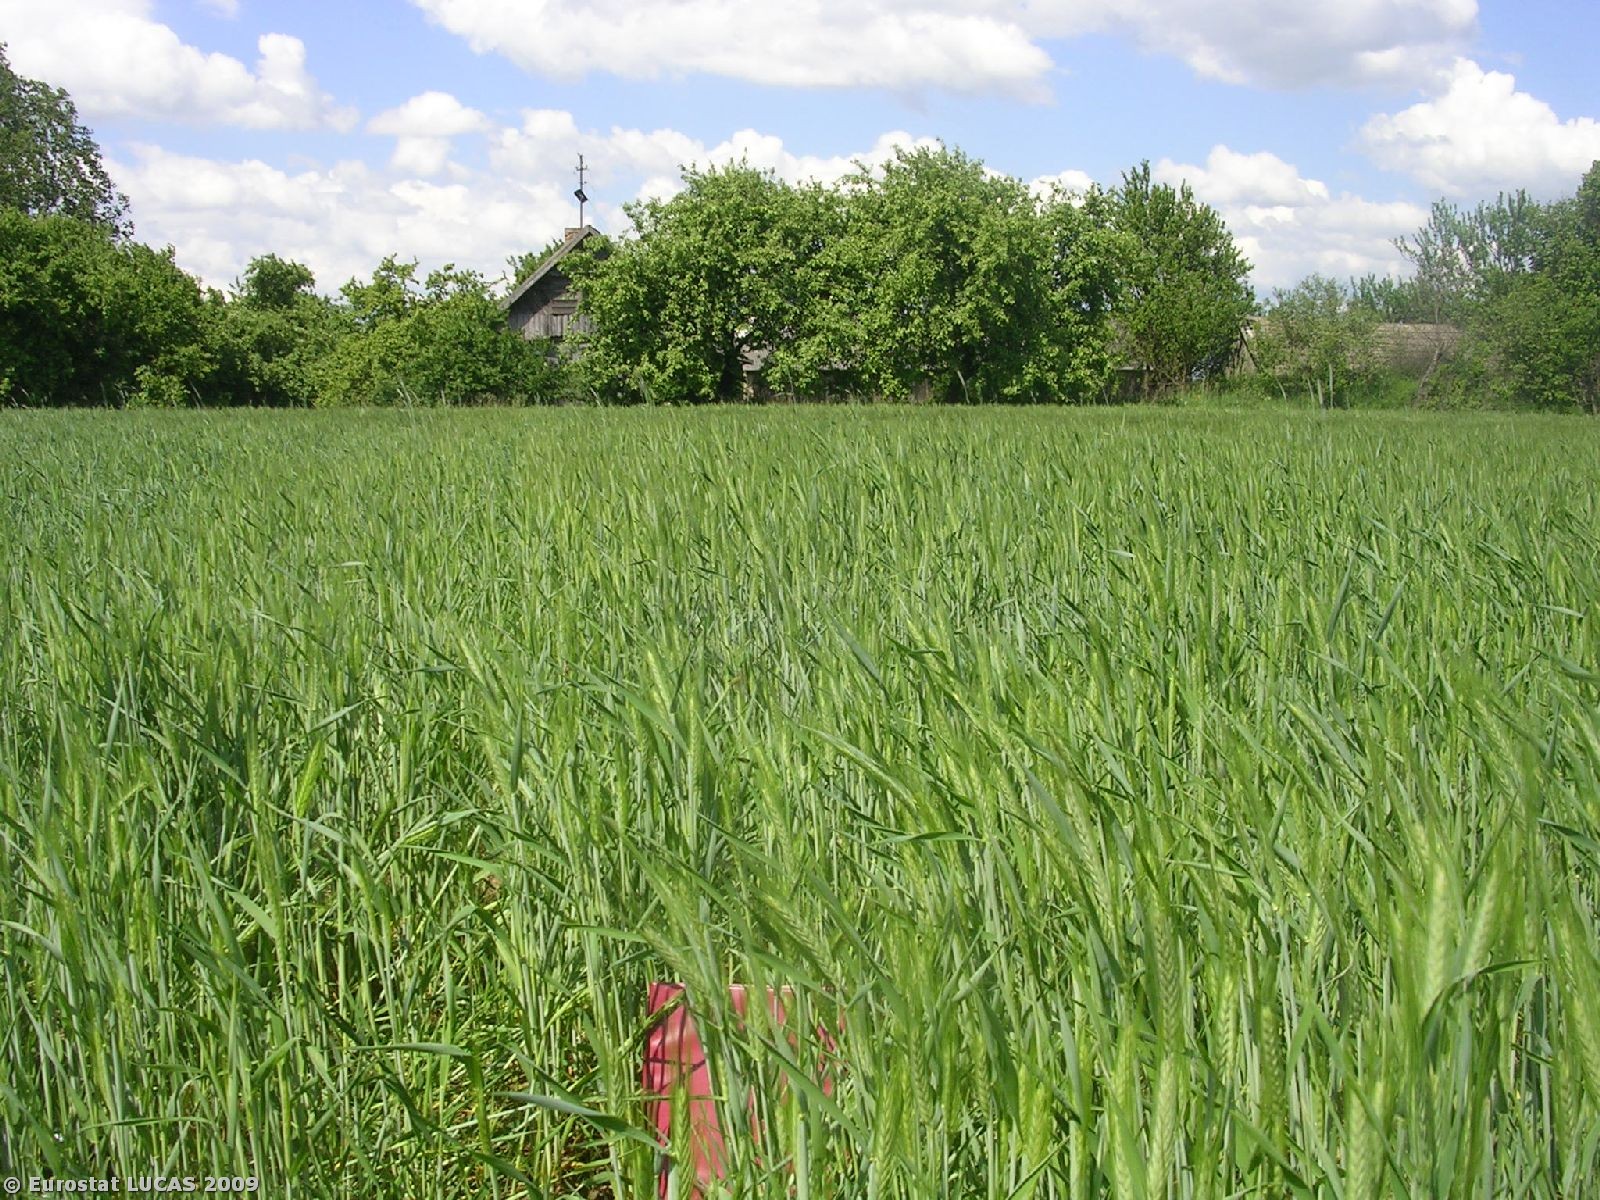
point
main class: Cropland
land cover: Barley
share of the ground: > 75 %
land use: Agriculture (excluding fallow land and kitchen gardens)
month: May
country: PL
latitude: 53.5522
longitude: 23.3482
